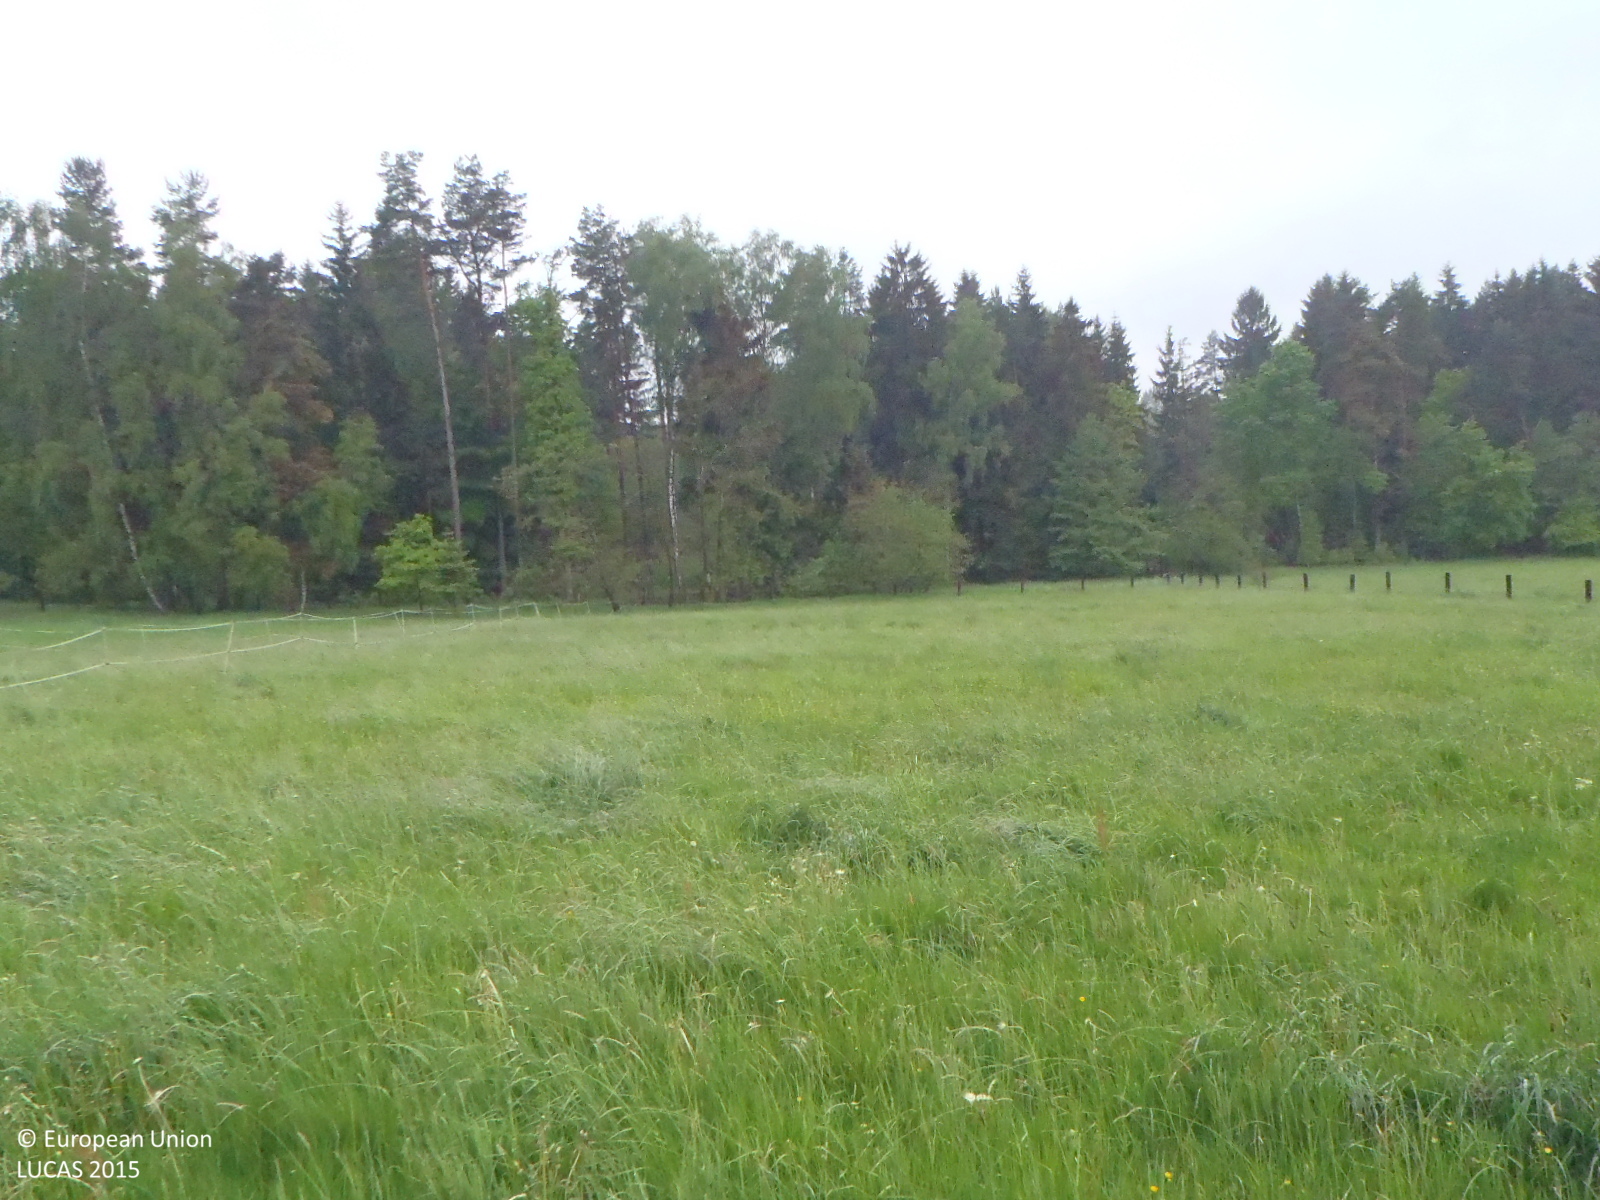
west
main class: Grassland
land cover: Grassland without tree/shrub cover
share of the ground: > 75 %
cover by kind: herbaceous plants 100 %
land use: Agriculture (excluding fallow land and kitchen gardens)
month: May
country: CZ
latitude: 48.7971
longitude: 14.5343
